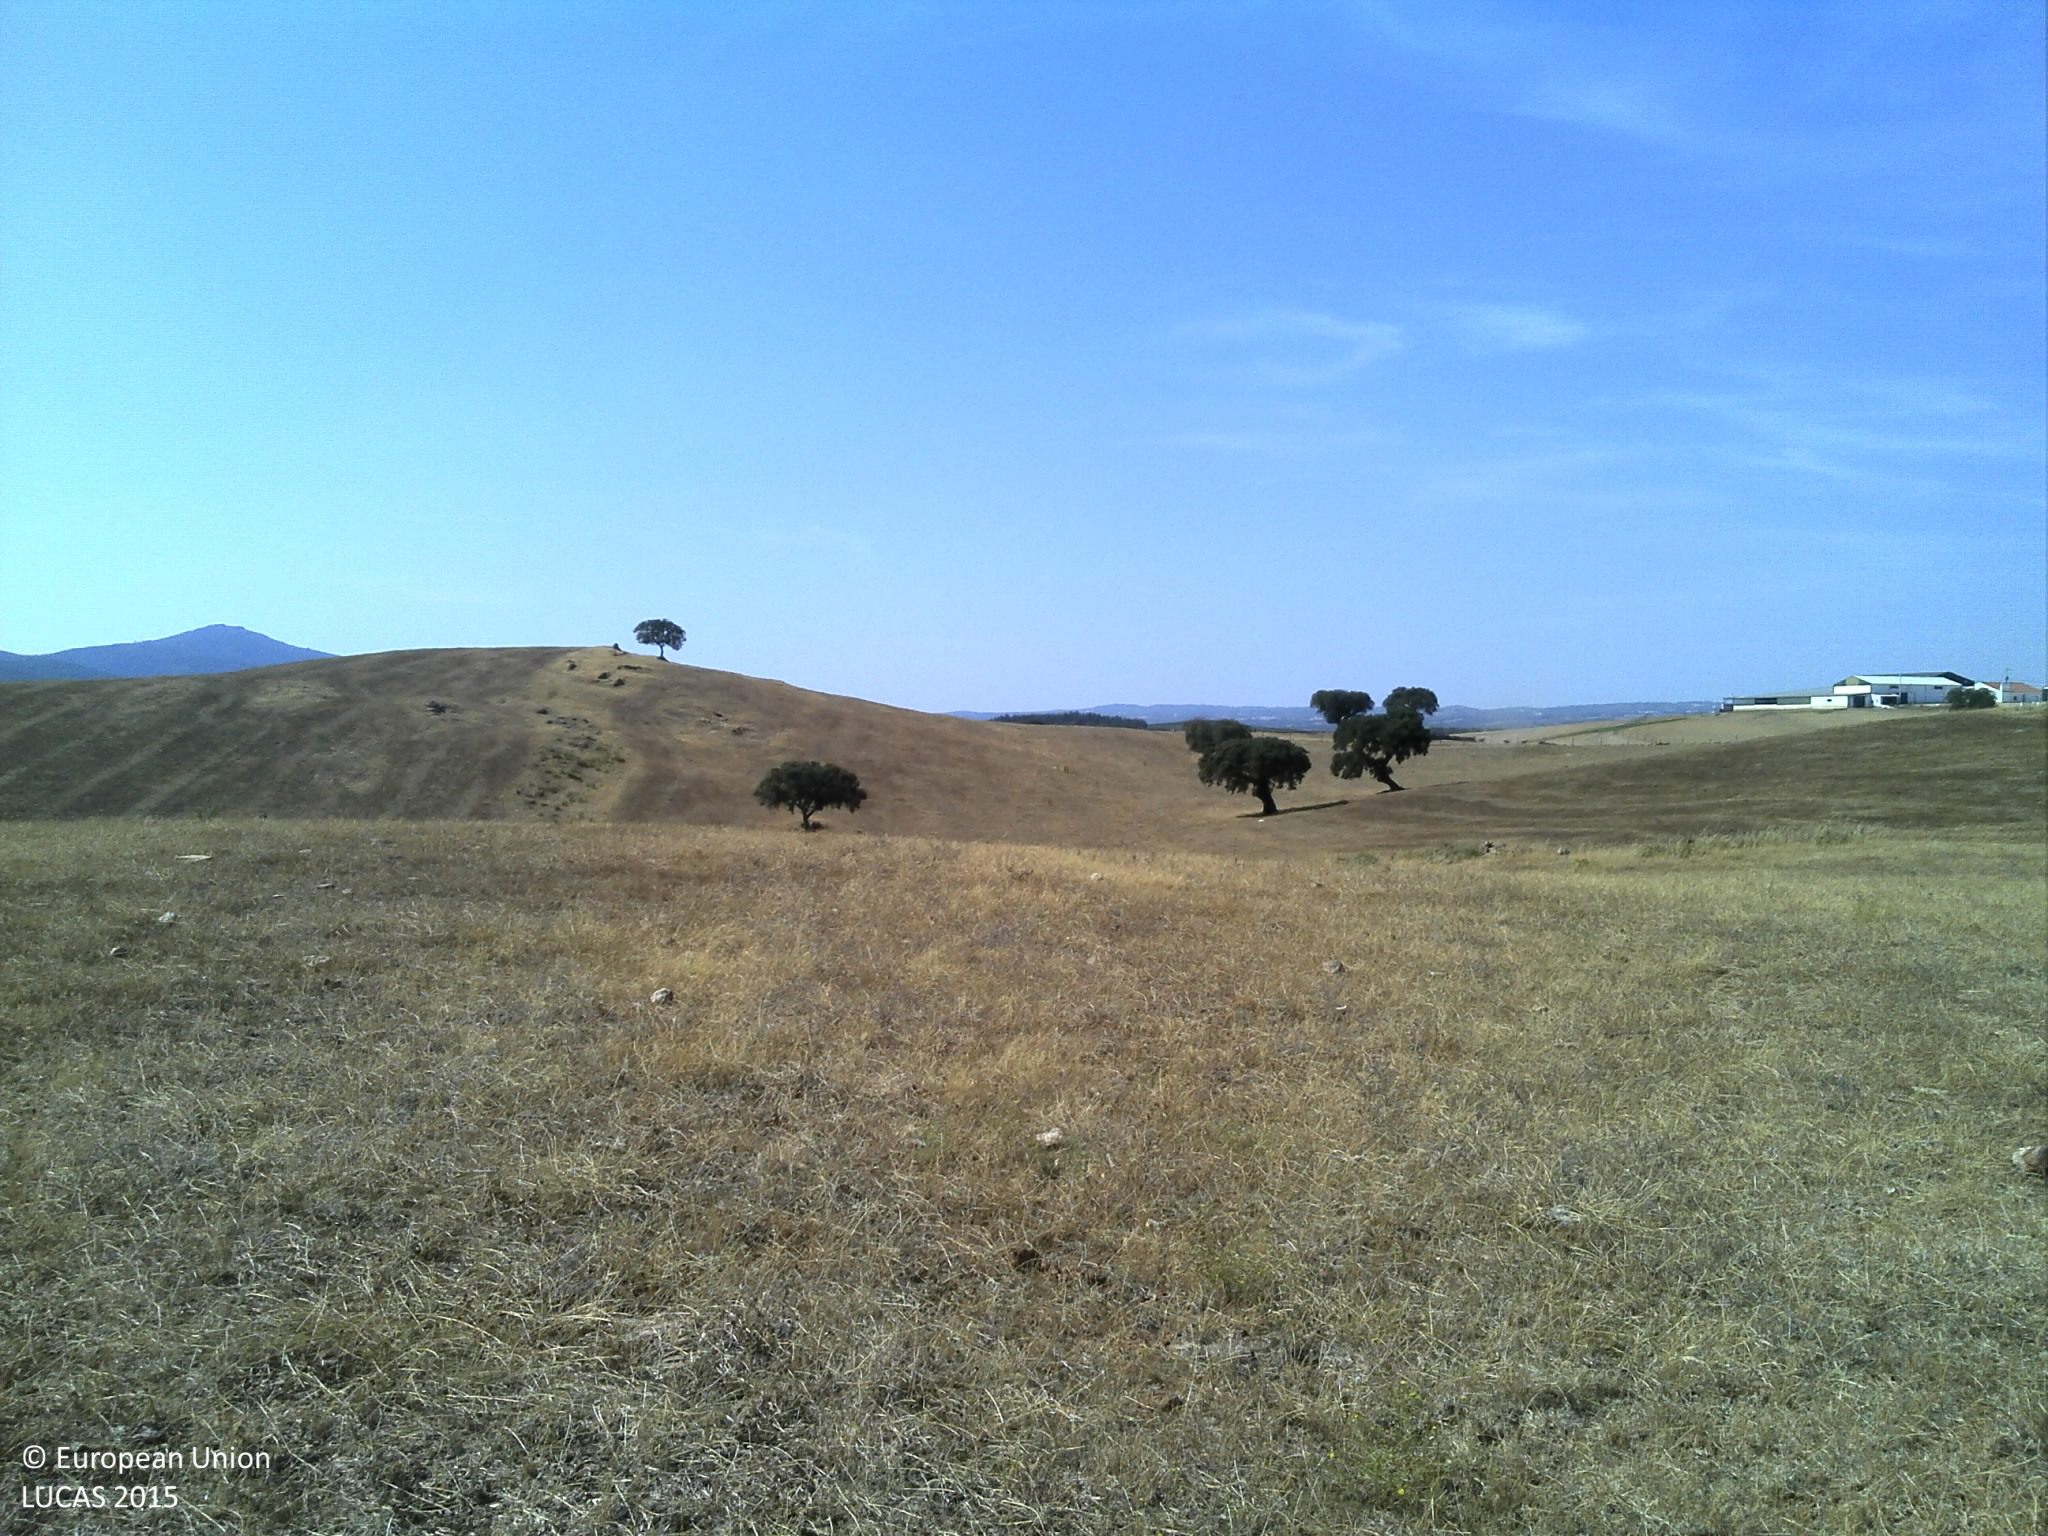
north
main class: Grassland
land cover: Grassland with sparse tree/shrub cover
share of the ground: 25 - 50 %
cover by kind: unconsolidated bare surface 50 %, herbaceous plants 45 %, broadleaved forest trees 5 %
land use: Agriculture (excluding fallow land and kitchen gardens)
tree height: > 5 m
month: July
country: PT
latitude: 38.6859
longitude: -7.4708
